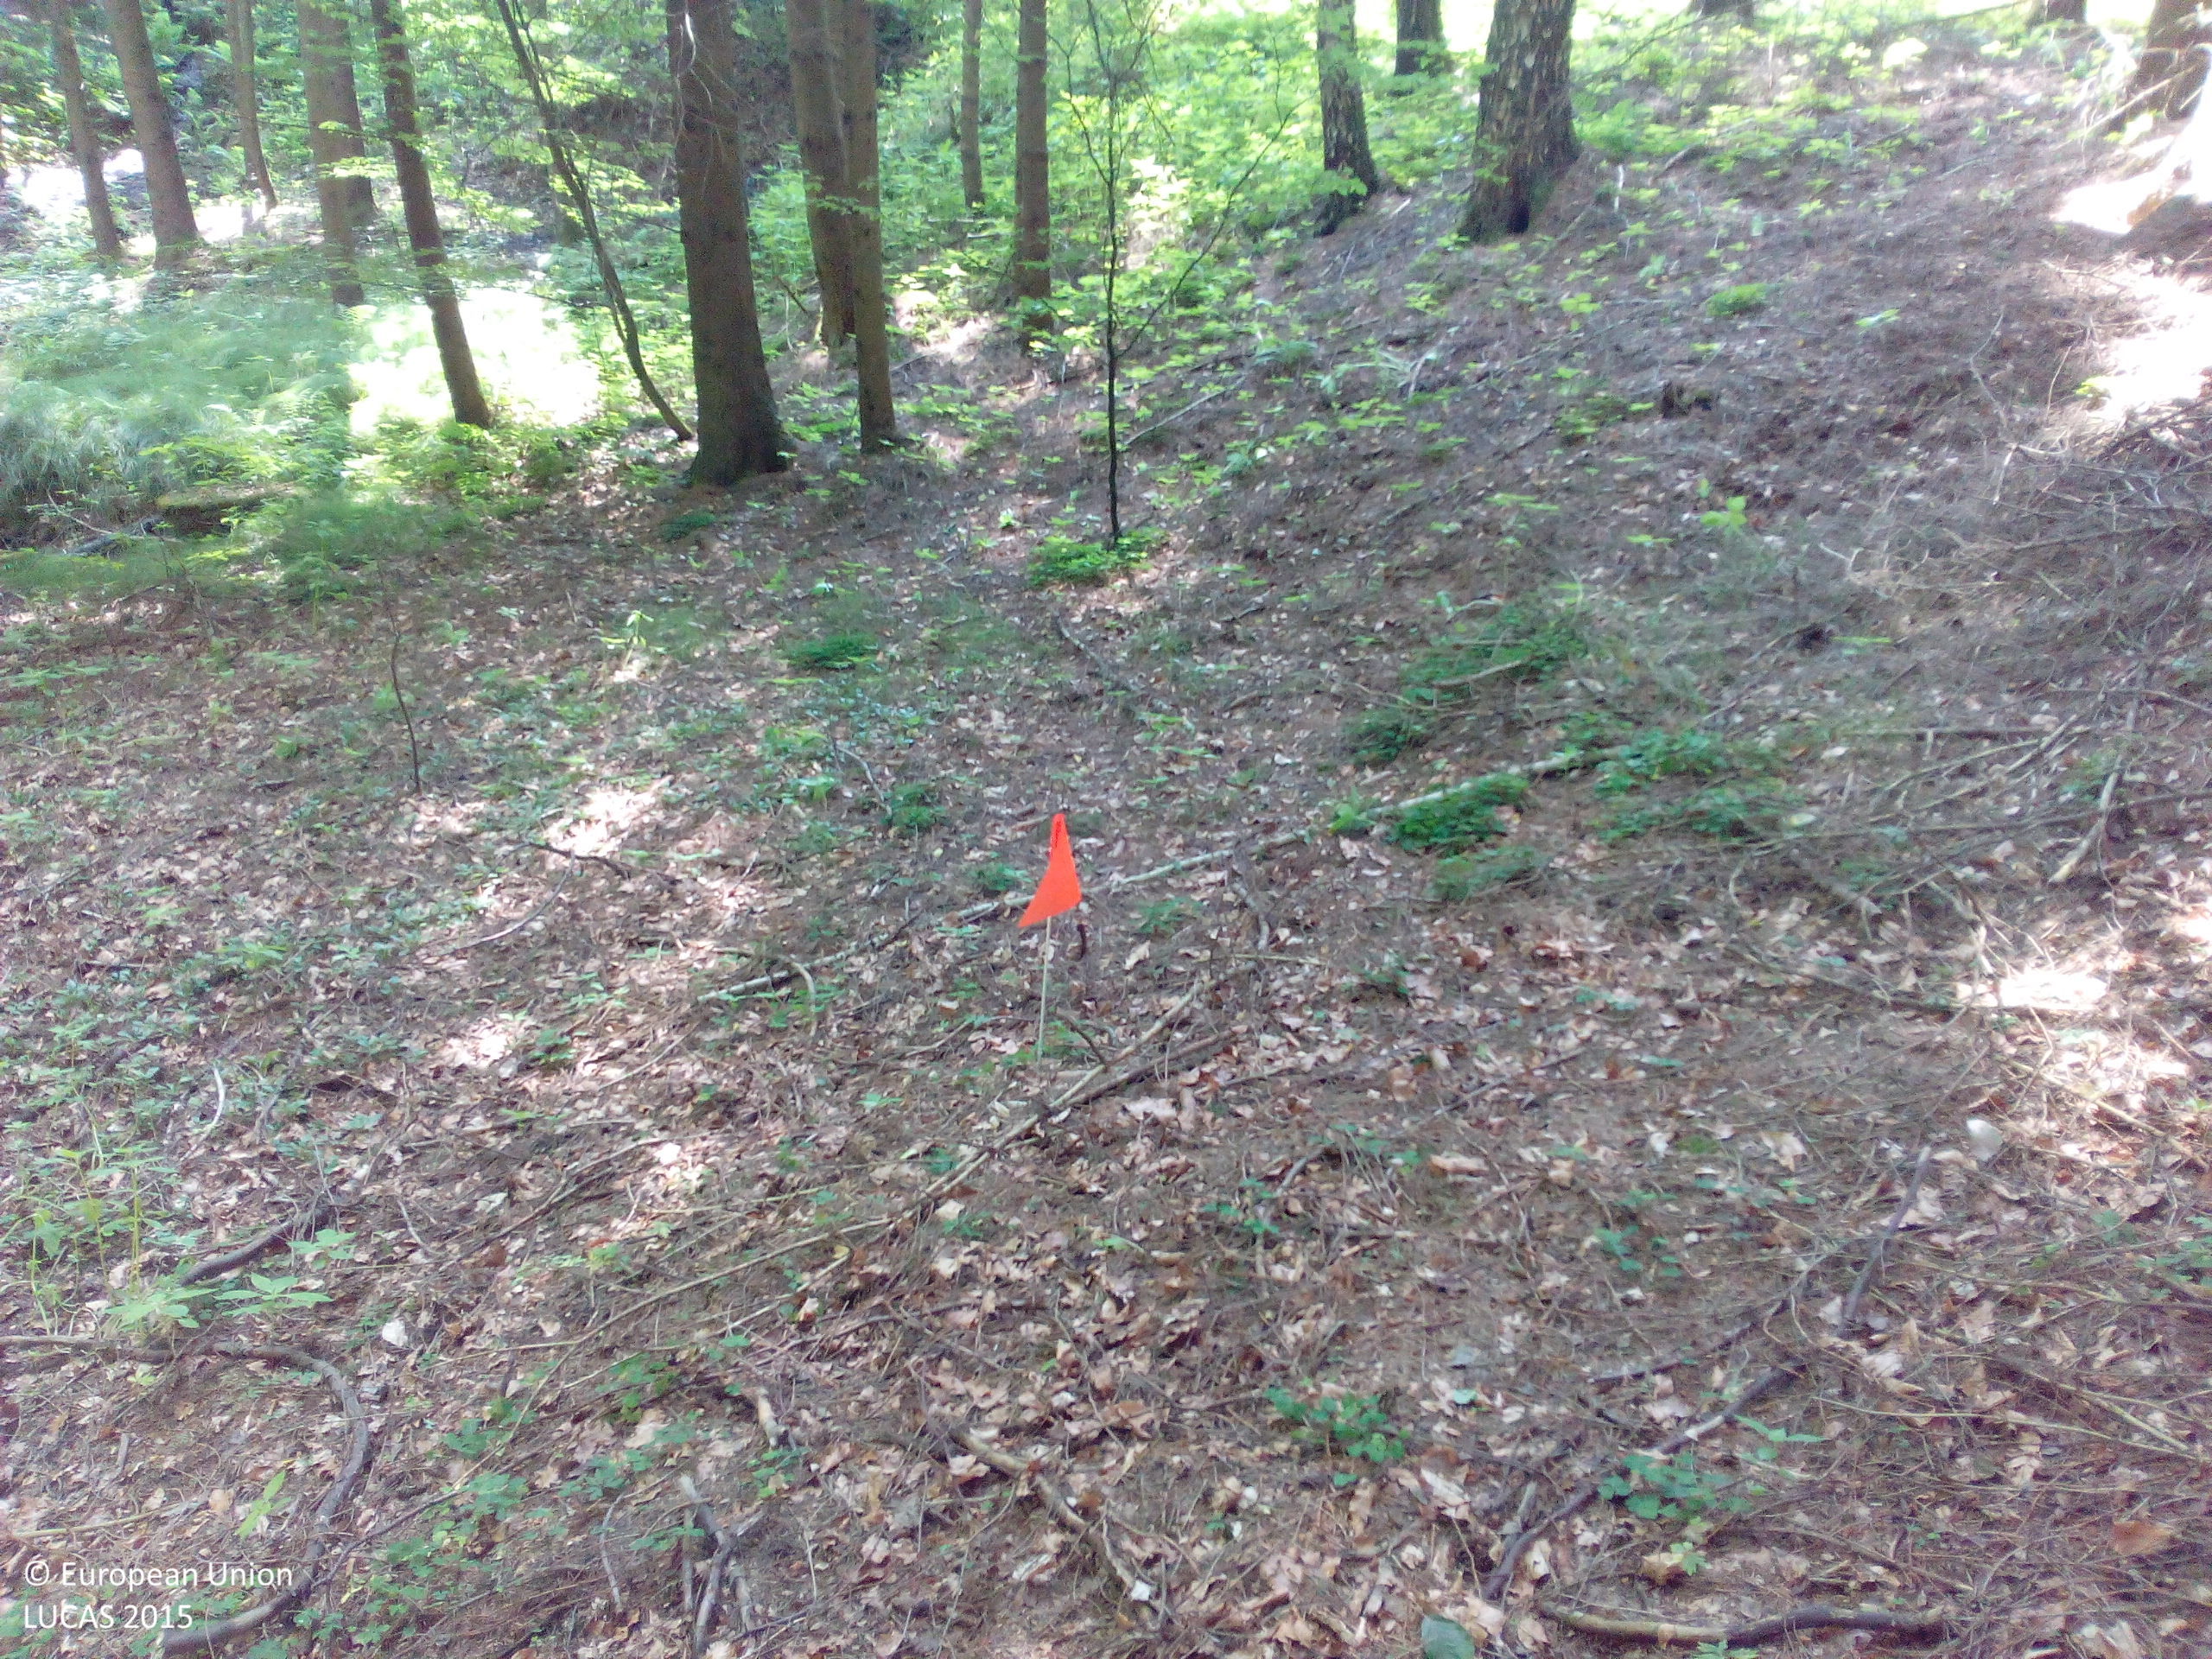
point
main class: Woodland
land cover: Spruce dominated mixed woodland
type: hemiboreal forest and nemoral coniferous forest and mixed broadleaved-coniferous forest
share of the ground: > 75 %
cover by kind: broadleaved forest trees 60 %, coniferous forest trees 25 %, unconsolidated bare surface 10 %, herbaceous plants 5 %
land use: Forestry
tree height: > 5 m
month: June
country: DE
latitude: 48.5086
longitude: 12.9366
